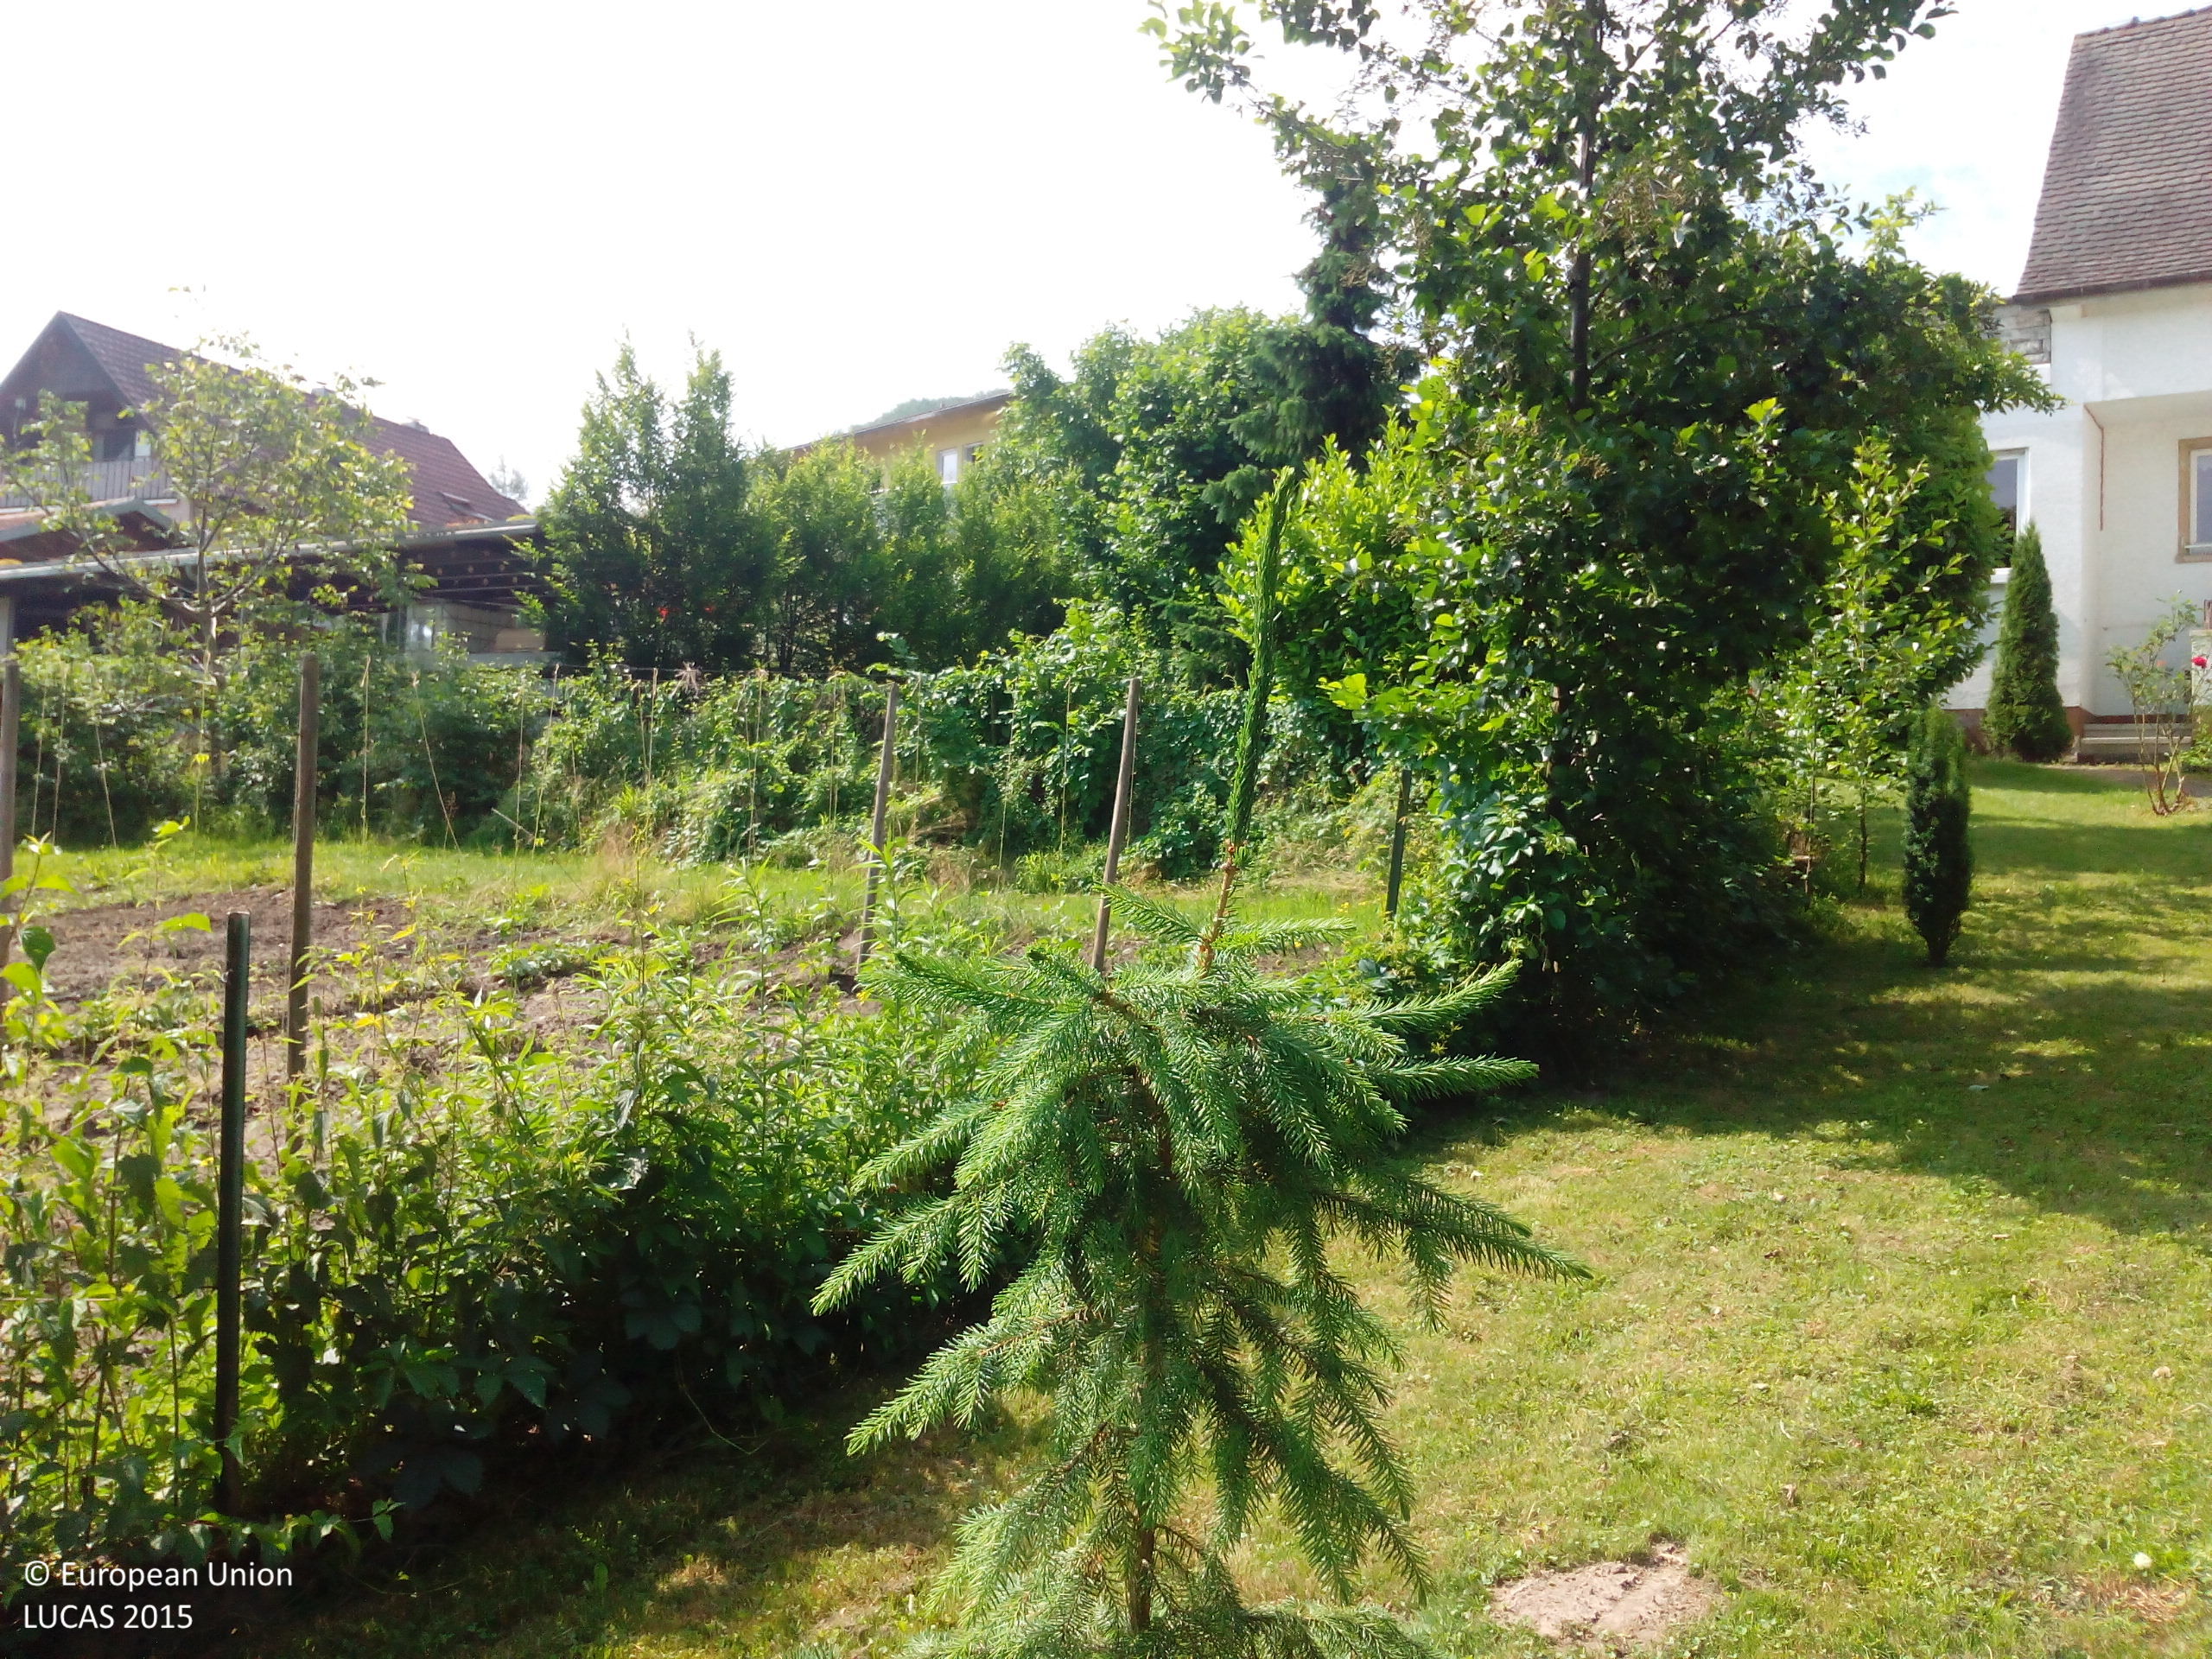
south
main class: Woodland
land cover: Broadleaved woodland
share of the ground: > 75 %
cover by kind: herbaceous plants 65 %, broadleaved forest trees 15 %, shrubs 10 %, consolidated bare surface 10 %
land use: Residential
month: June
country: DE
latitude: 48.1271
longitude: 7.6768
